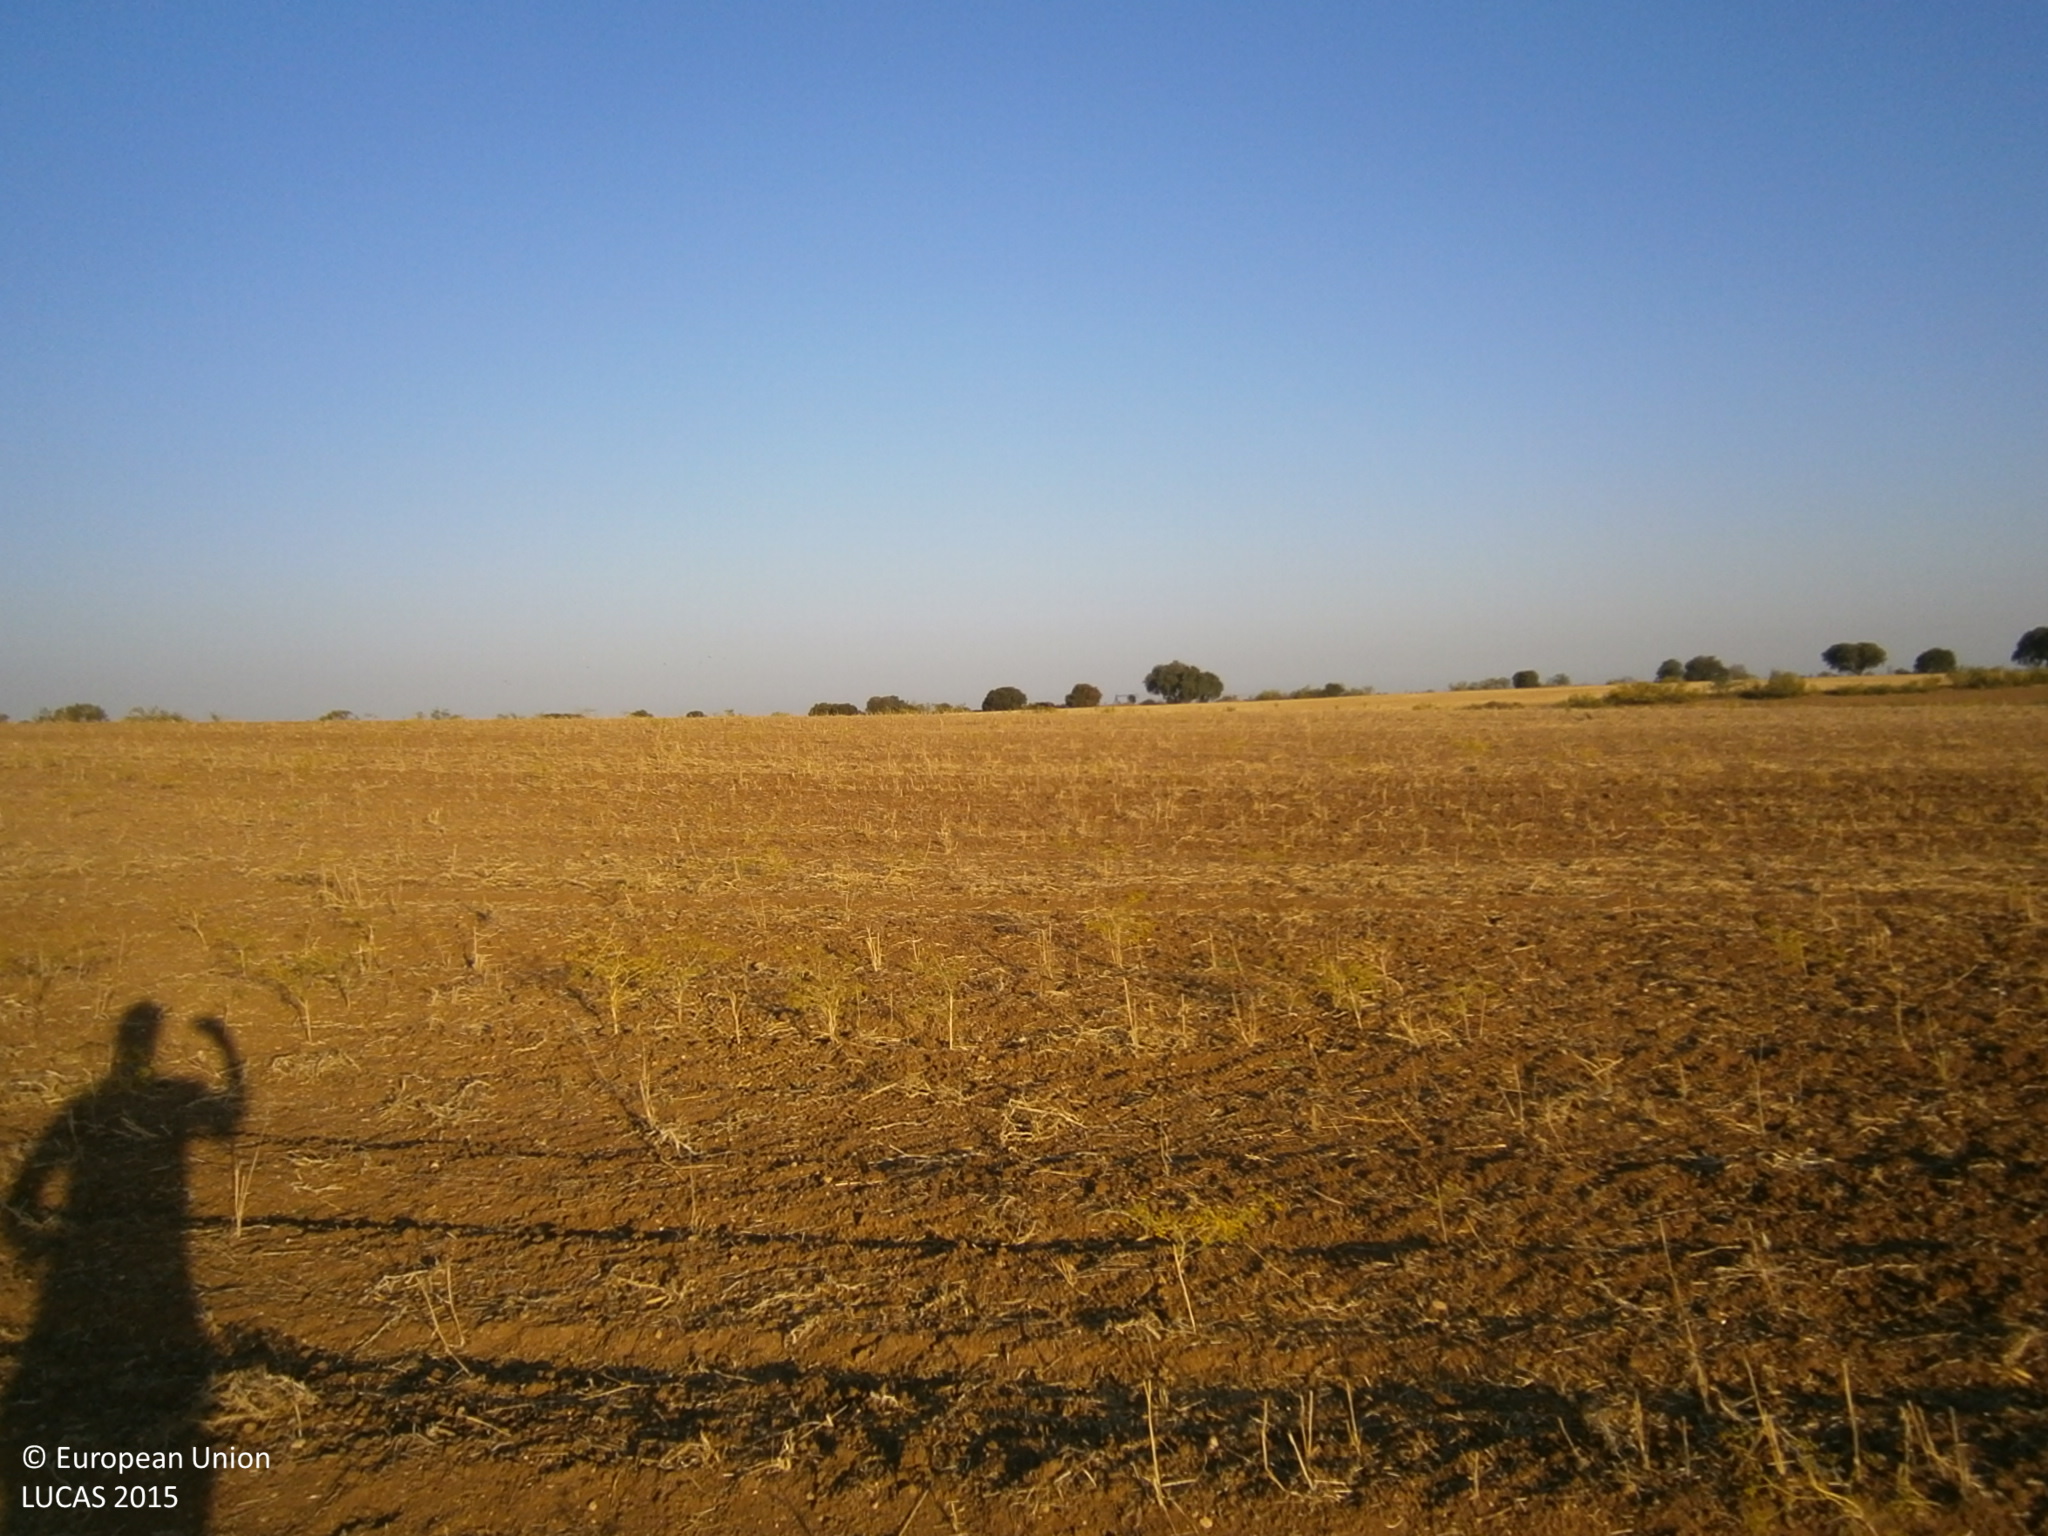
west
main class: Grassland
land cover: Spontaneously vegetated surfaces
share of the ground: 25 - 50 %
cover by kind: unconsolidated bare surface 65 %, herbaceous plants 30 %
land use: Agriculture (excluding fallow land and kitchen gardens)
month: June
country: ES
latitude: 38.7739
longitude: -6.8824
